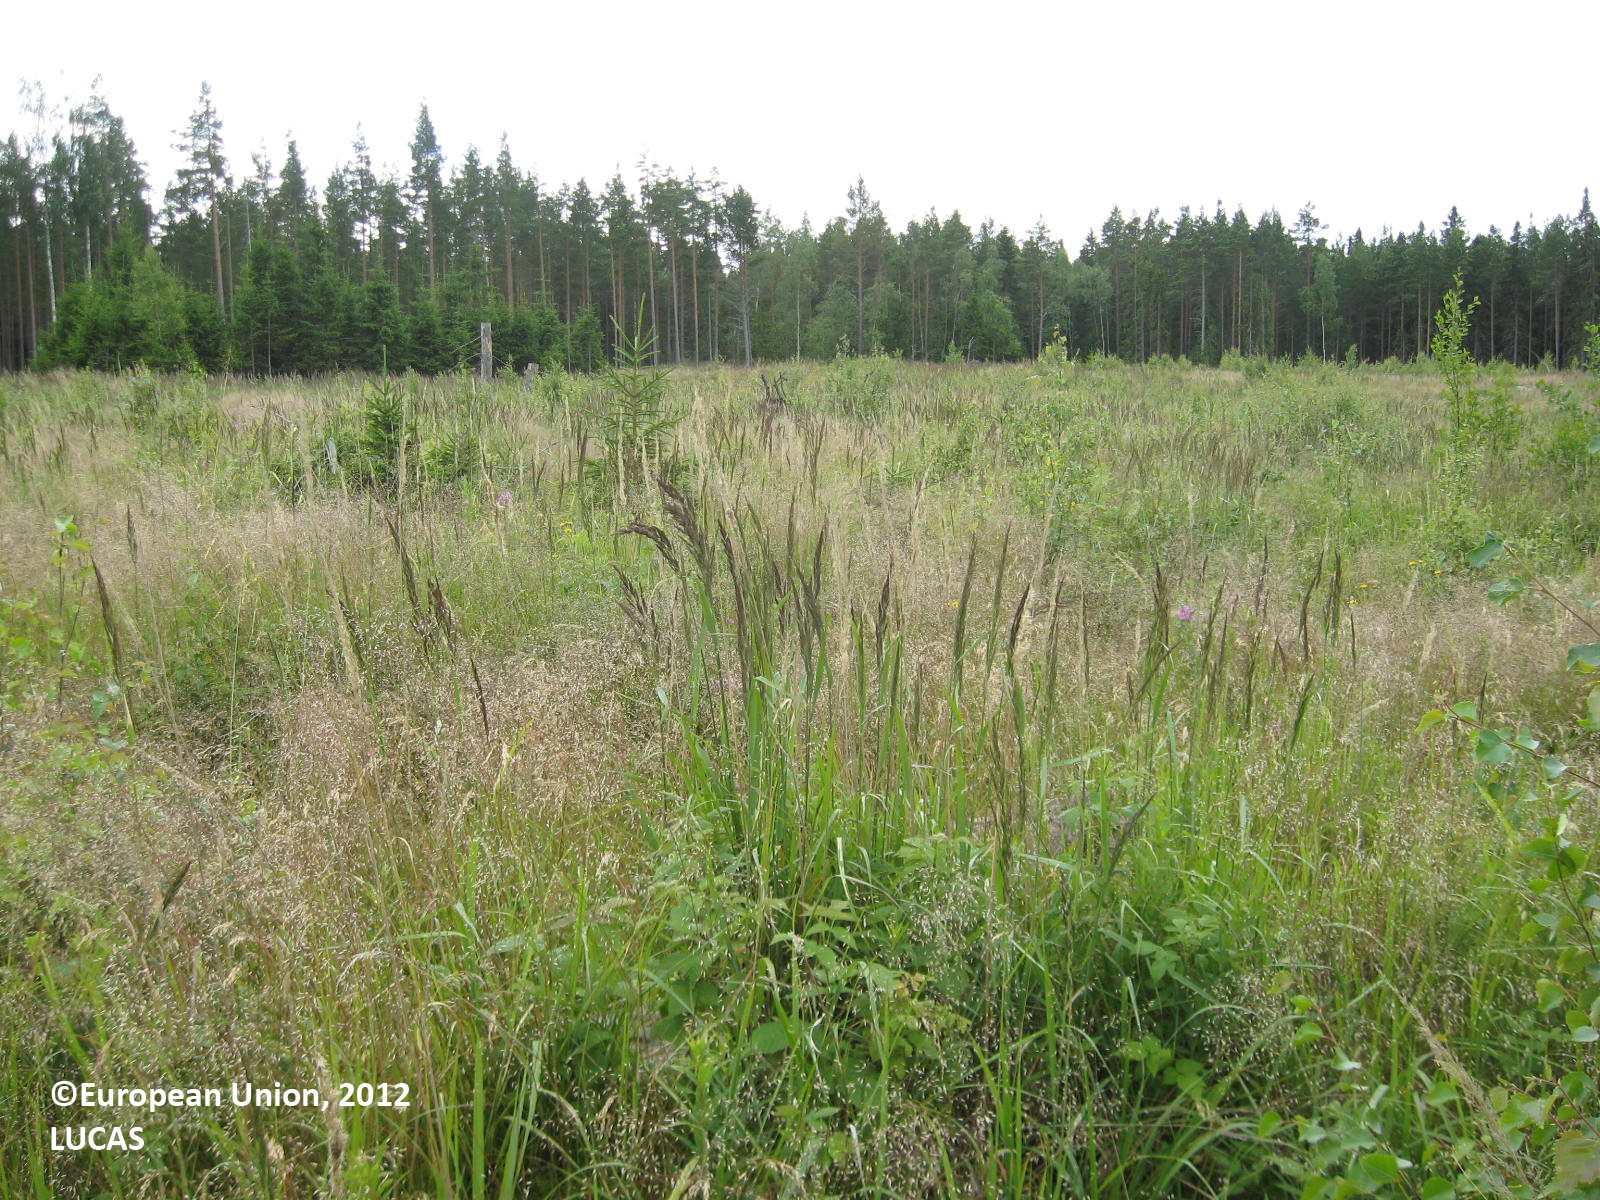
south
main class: Woodland
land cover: Broadleaved woodland
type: boreal forest
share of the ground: 10 - 25 %
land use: Forestry
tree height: < 5 m
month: July
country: FI
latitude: 61.9803
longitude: 21.3609
